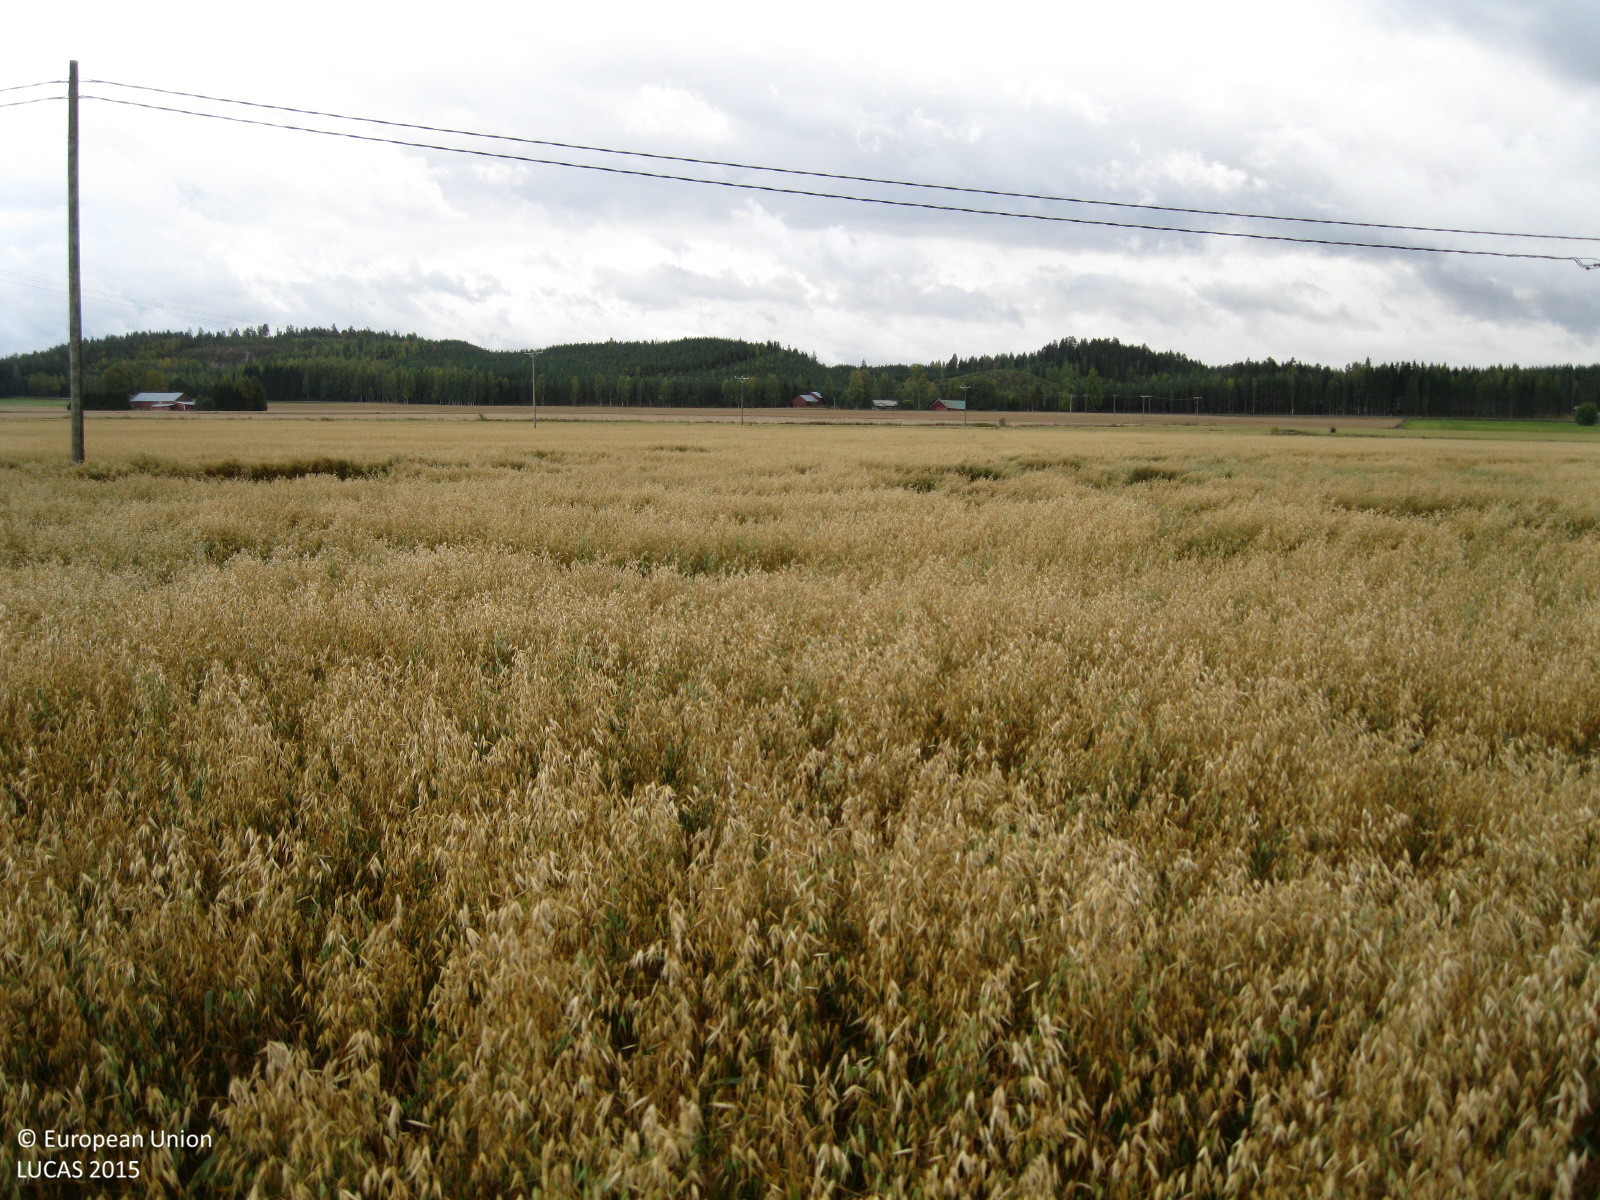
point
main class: Cropland
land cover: Oats
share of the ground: > 75 %
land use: Agriculture (excluding fallow land and kitchen gardens)
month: September
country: FI
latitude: 60.8862
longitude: 24.7569
